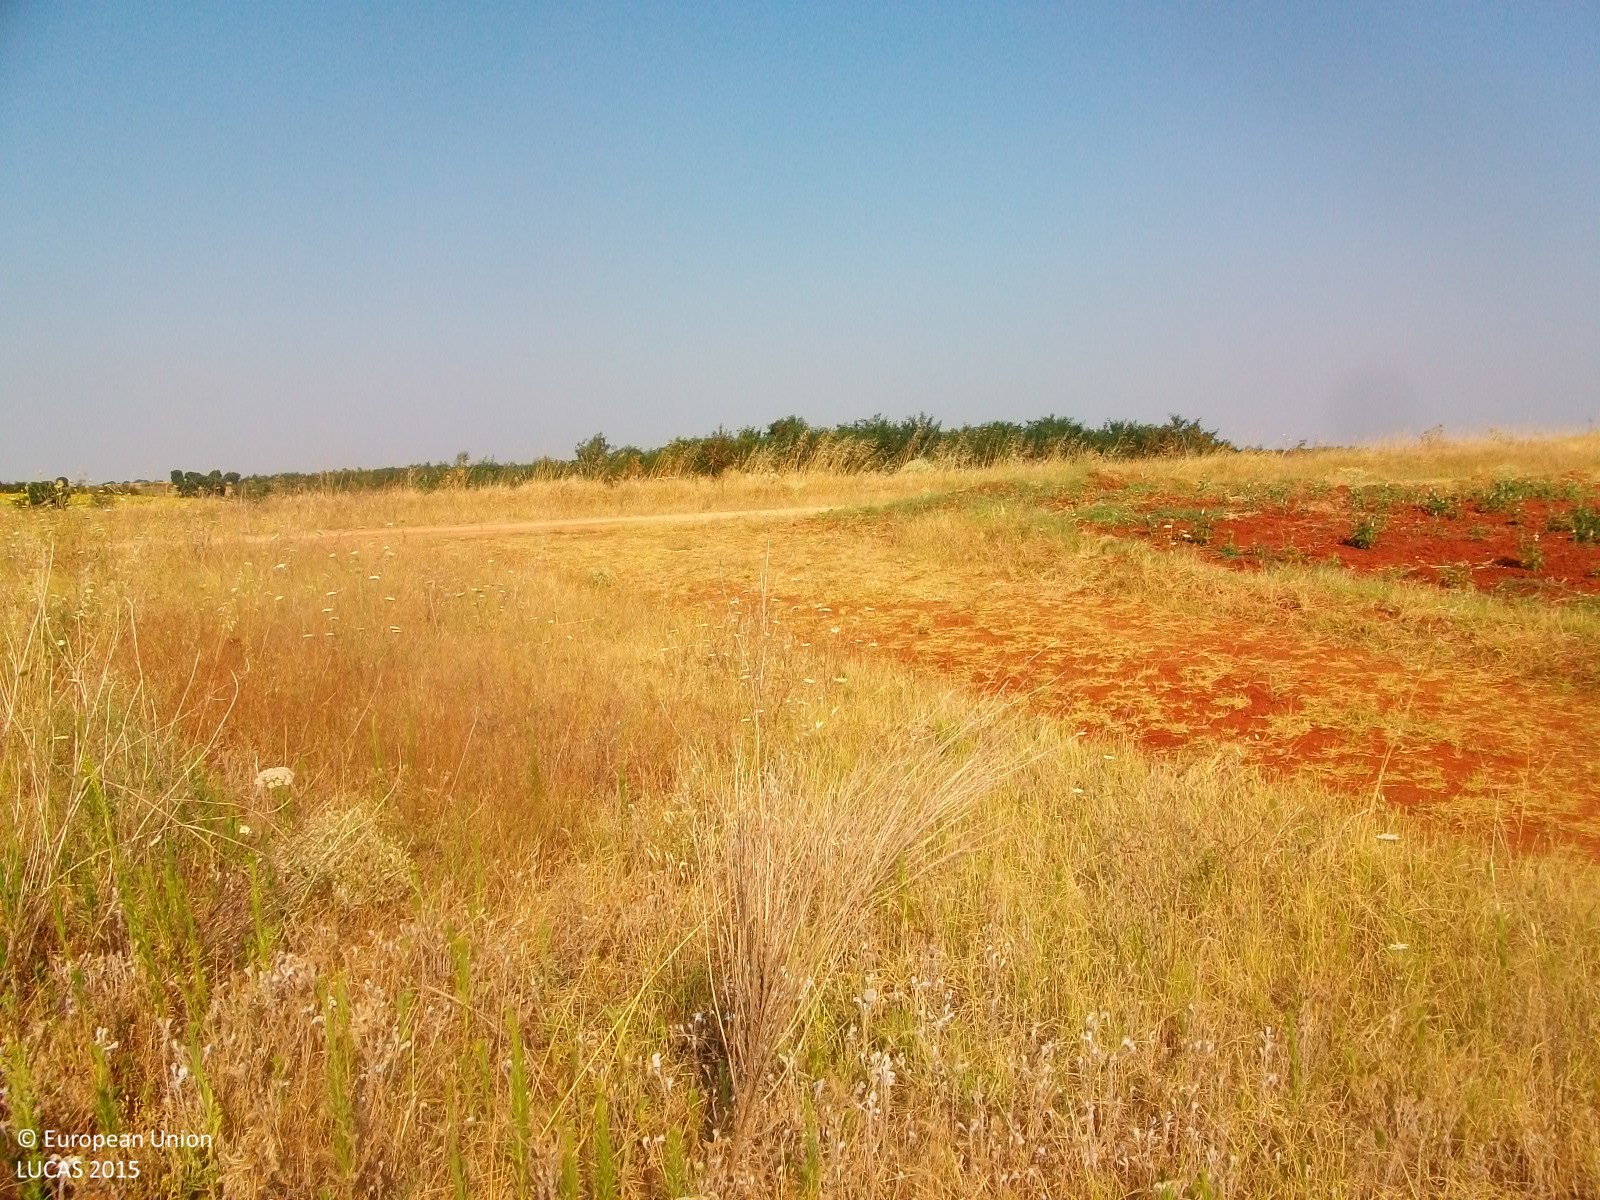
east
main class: Grassland
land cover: Spontaneously vegetated surfaces
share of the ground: > 75 %
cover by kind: herbaceous plants 100 %
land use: Fallow land
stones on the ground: 25 - 50 %
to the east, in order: Spontaneously vegetated surfaces; Tracks; Spontaneously vegetated surfaces; Broadleaved woodland; Cotton
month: July
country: GR
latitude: 41.3297
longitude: 26.2608
